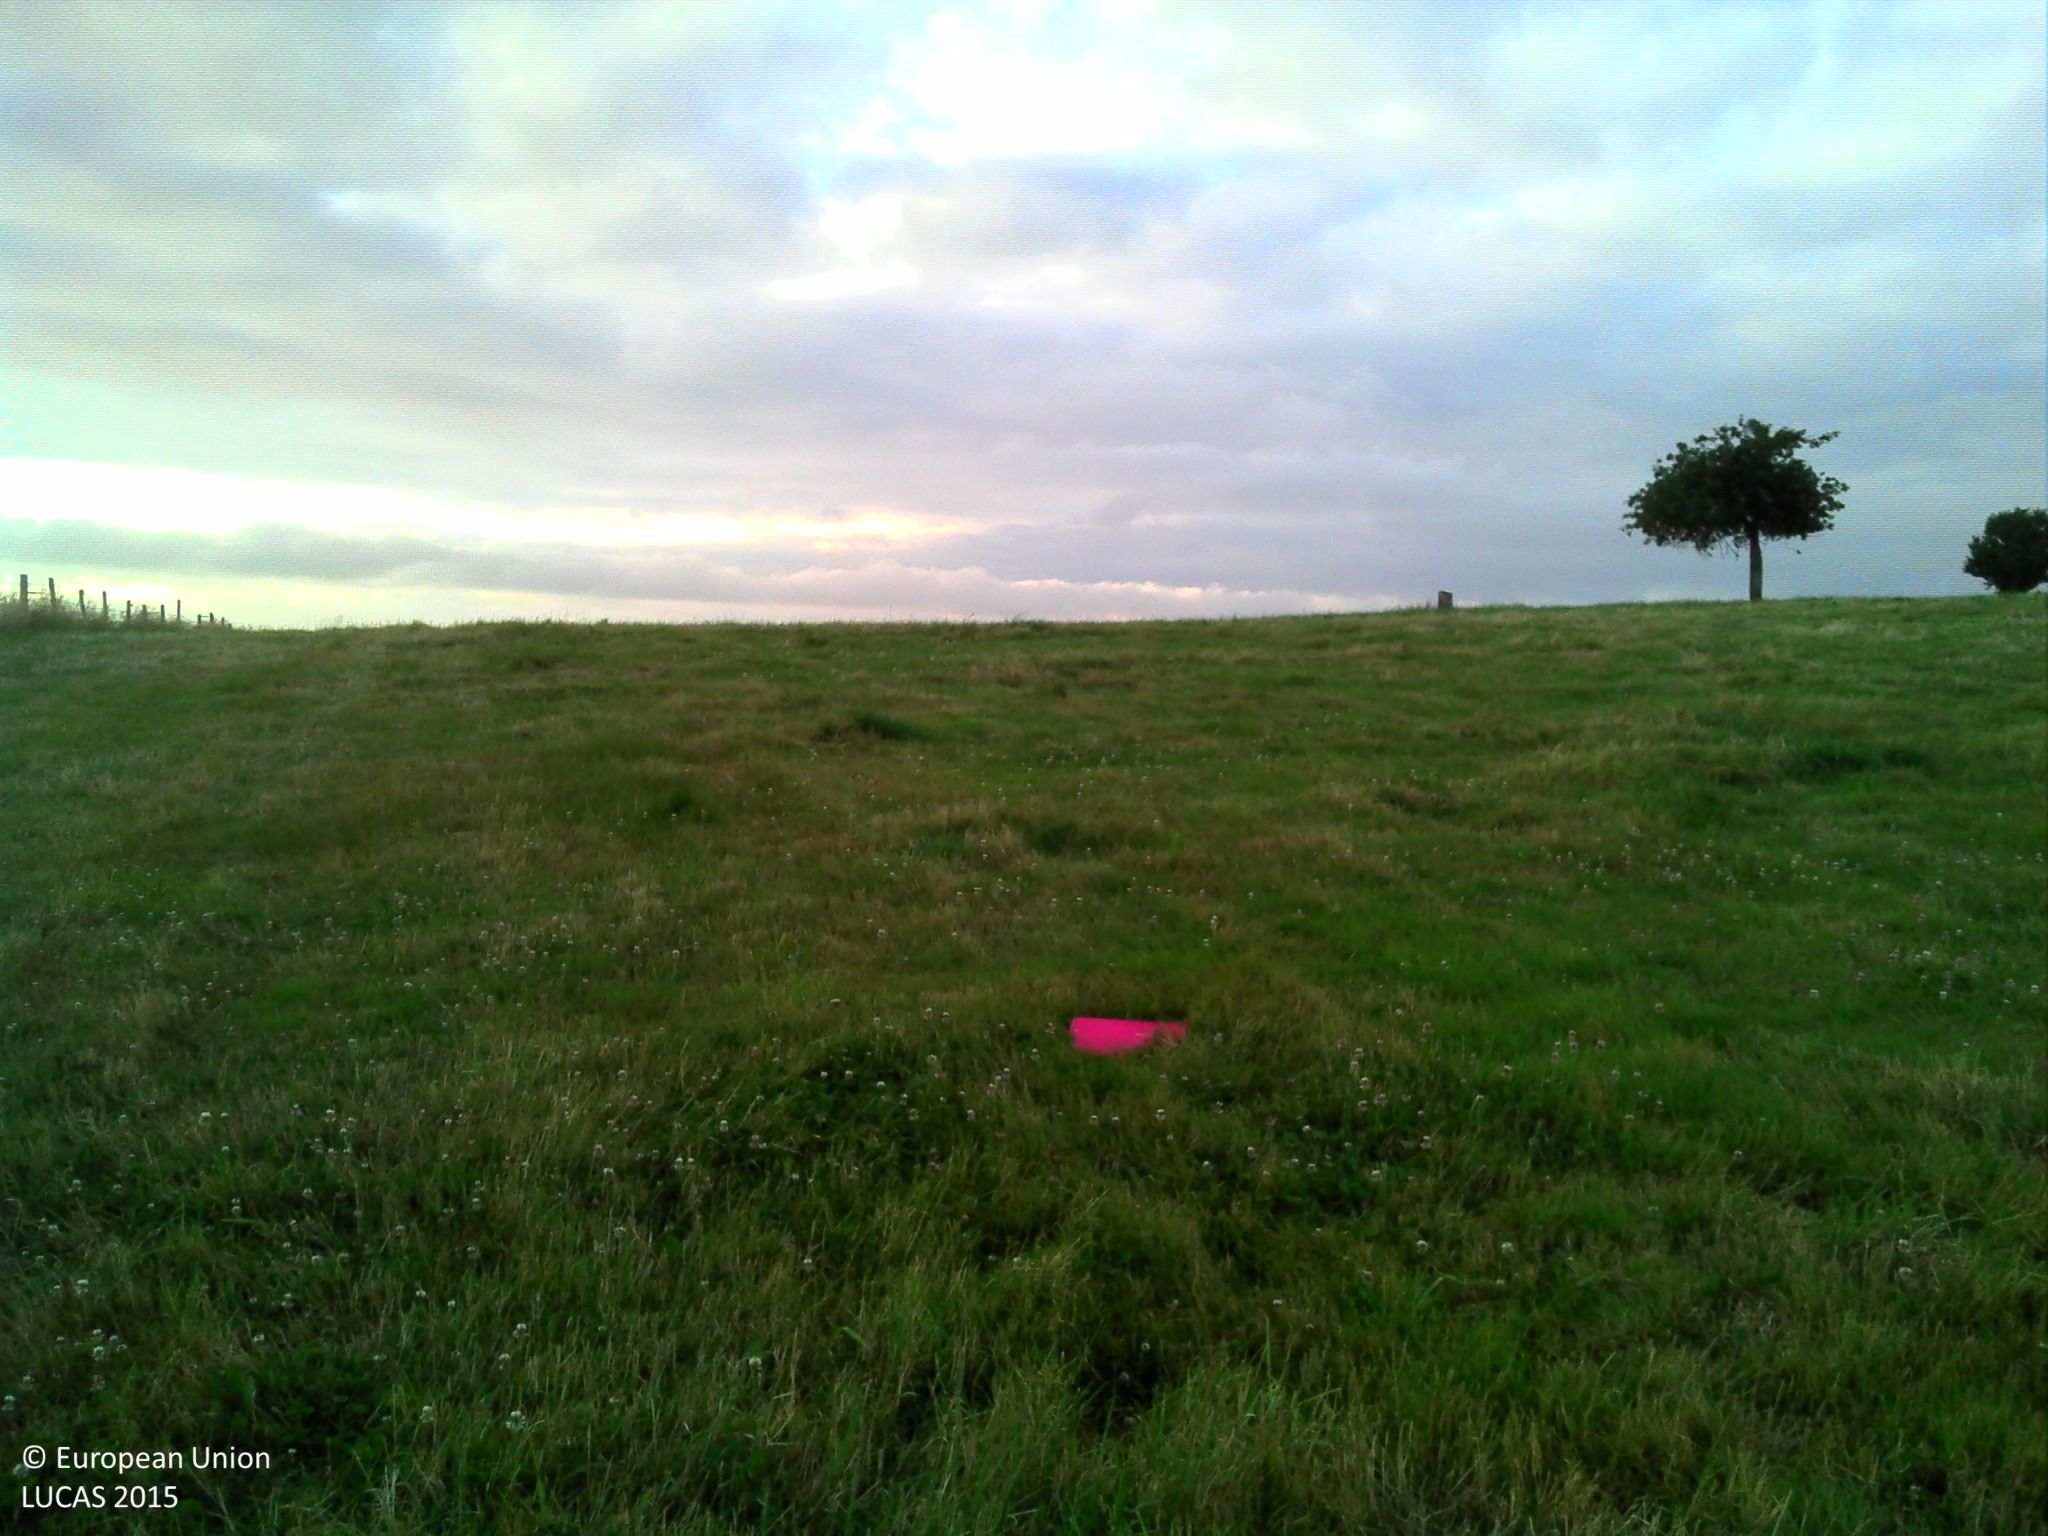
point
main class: Grassland
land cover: Grassland without tree/shrub cover
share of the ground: > 75 %
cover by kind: herbaceous plants 100 %
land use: Agriculture (excluding fallow land and kitchen gardens)
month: June
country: FR
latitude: 47.9708
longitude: -1.4434
